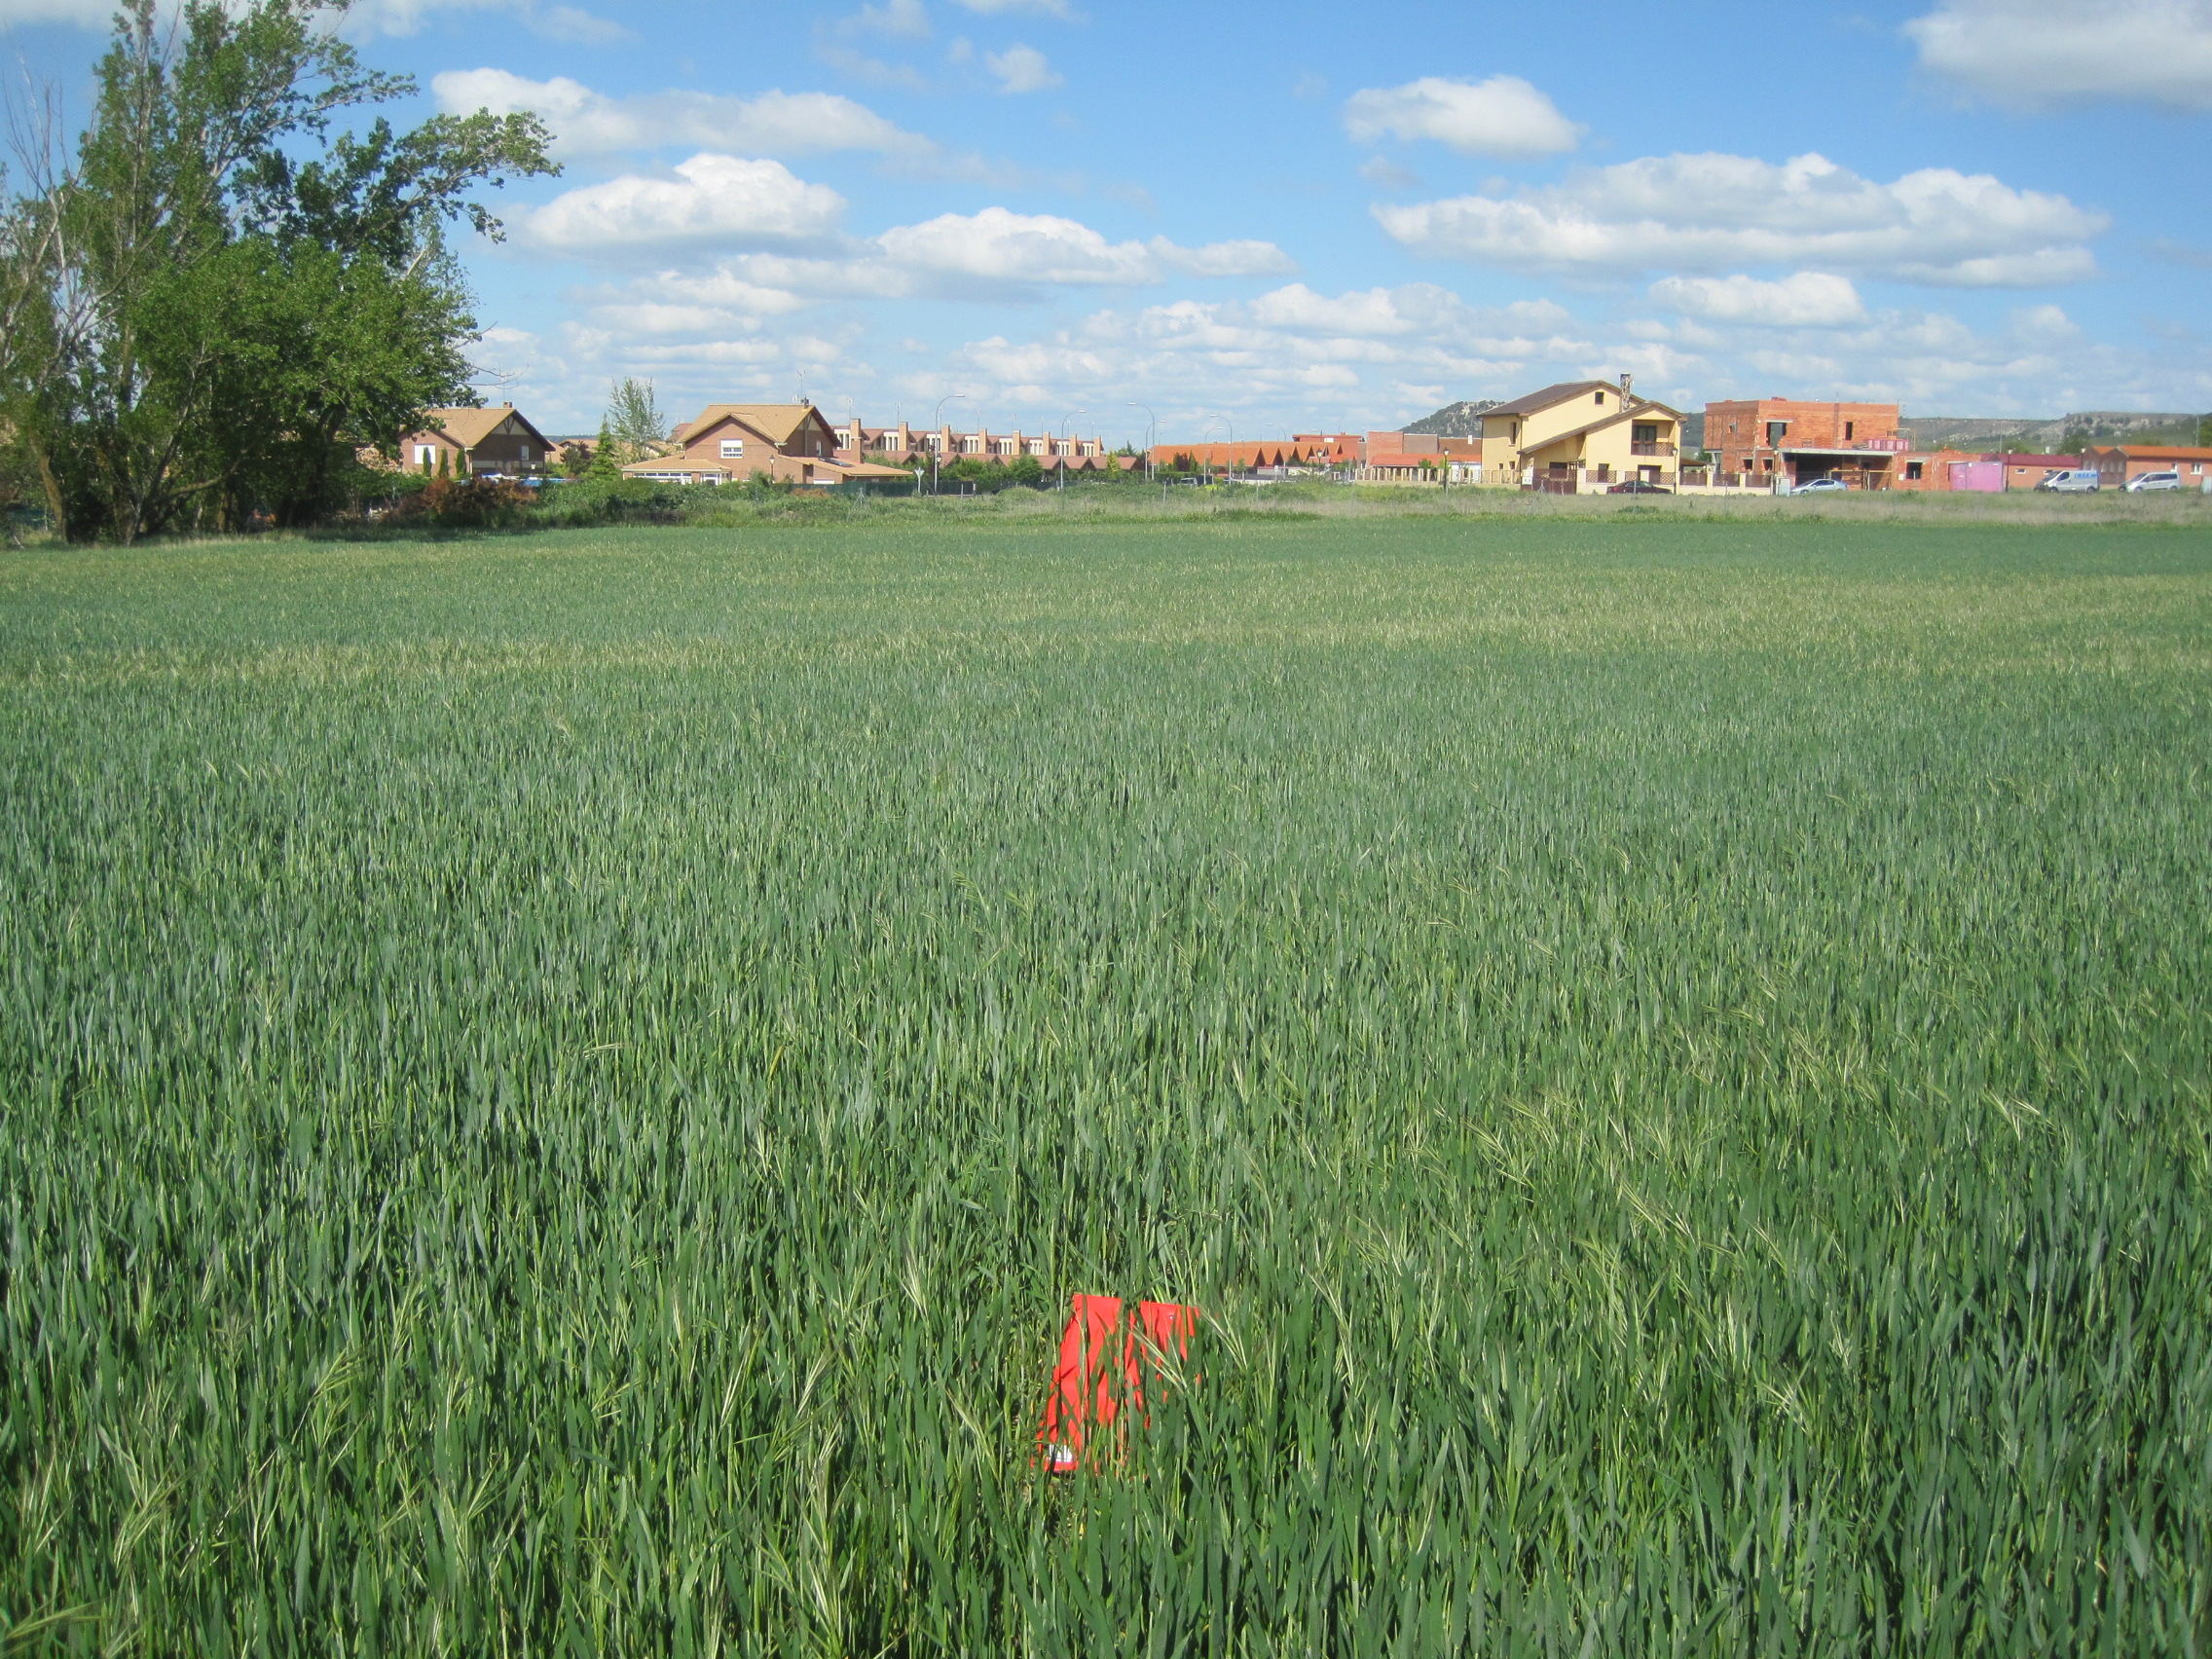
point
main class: Cropland
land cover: Common wheat
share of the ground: > 75 %
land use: Agriculture (excluding fallow land and kitchen gardens)
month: May
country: ES
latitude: 41.6367
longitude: -4.6534
